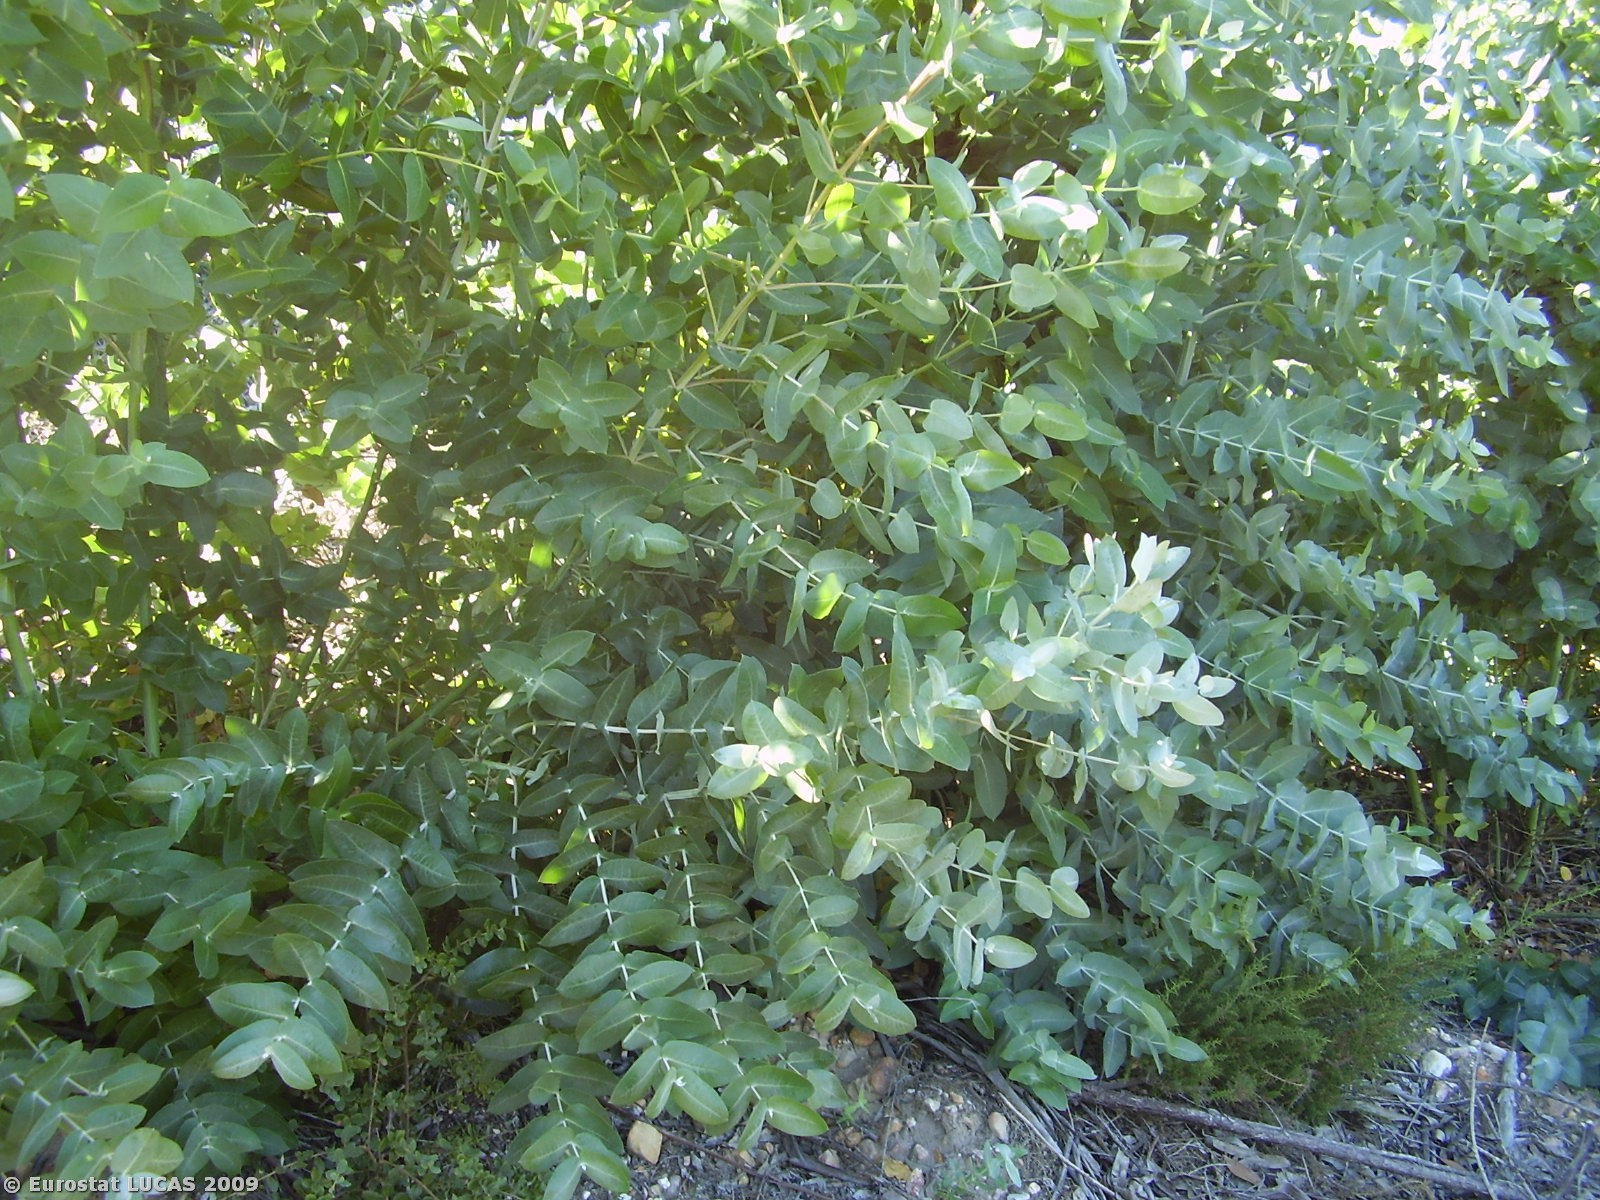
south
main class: Woodland
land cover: Broadleaved woodland
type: plantations and self-sown exotic forest
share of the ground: 50 - 75 %
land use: Forestry
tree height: > 5 m
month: July
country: PT
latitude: 39.3924
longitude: -8.1393
